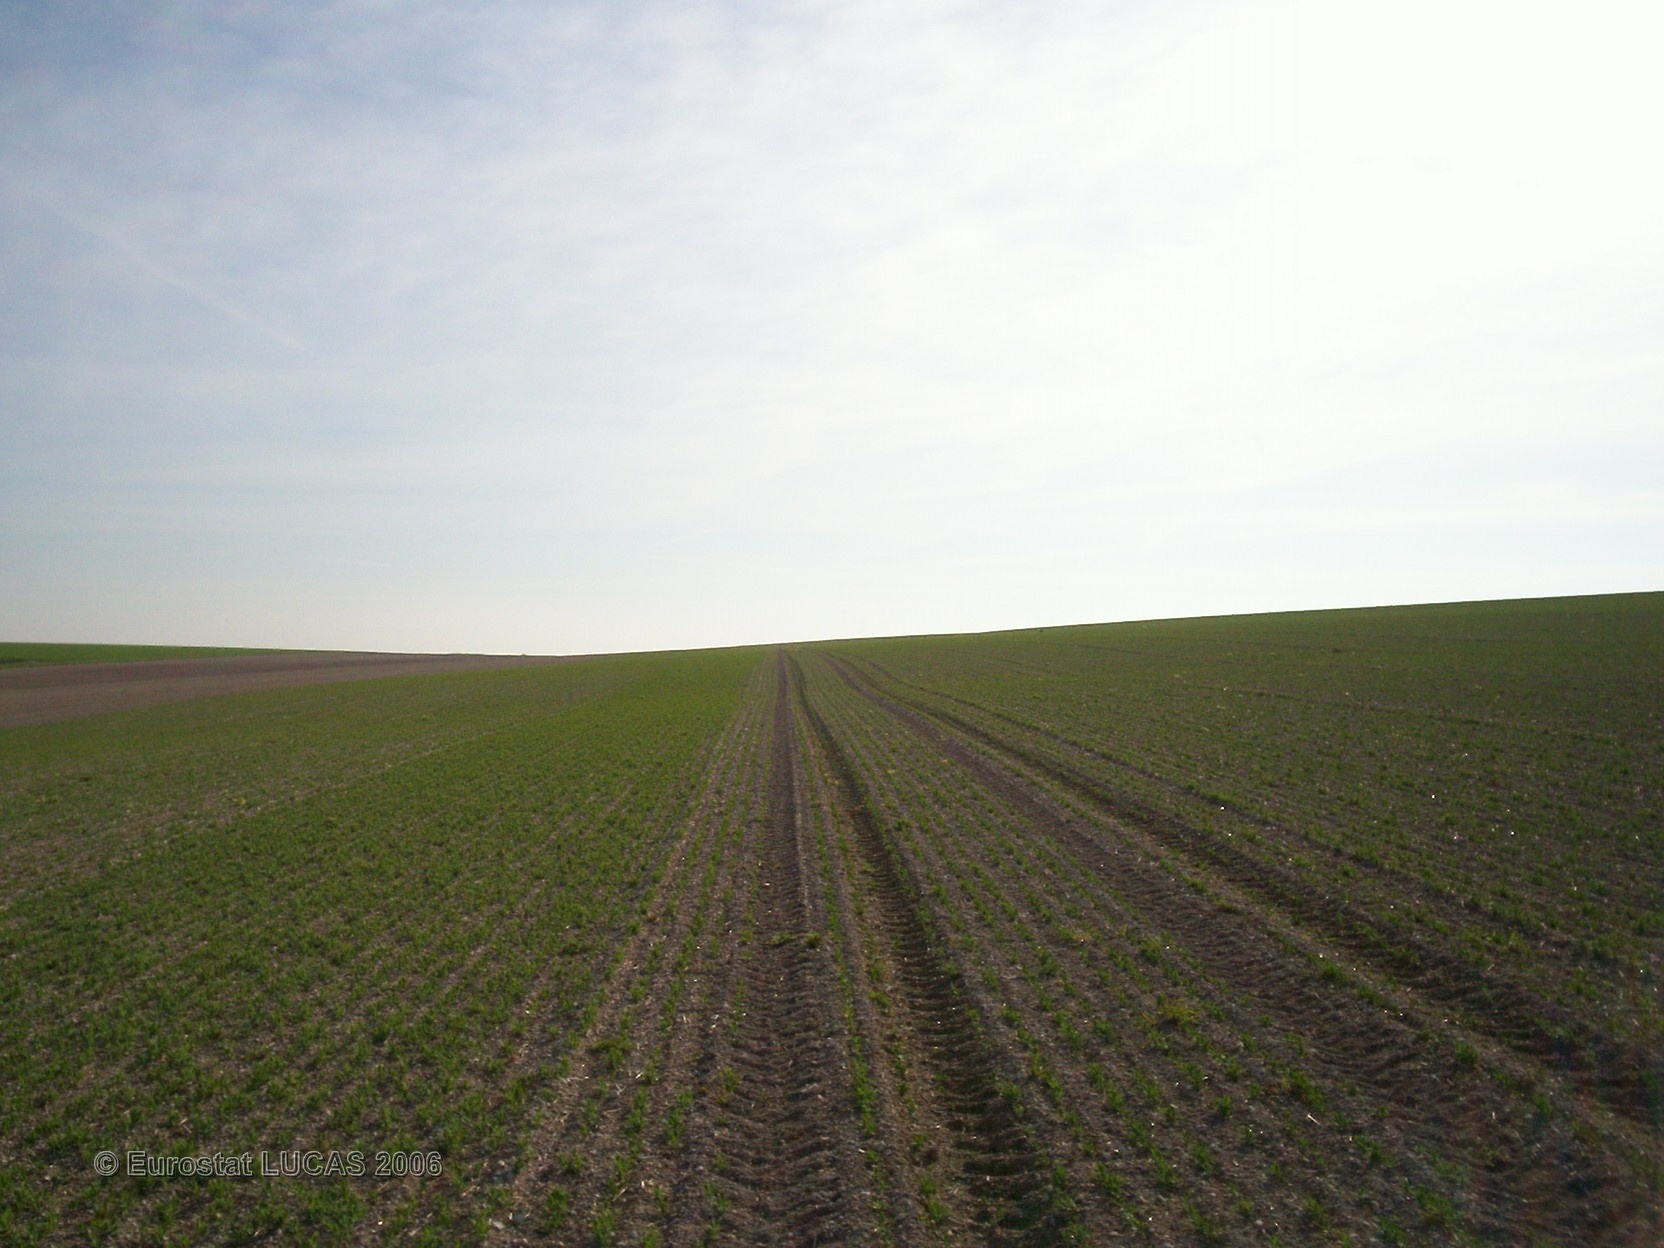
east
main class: Cropland
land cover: Dry pulses
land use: Agriculture (excluding fallow land and kitchen gardens)
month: May
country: FR
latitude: 48.7848
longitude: 4.4028
